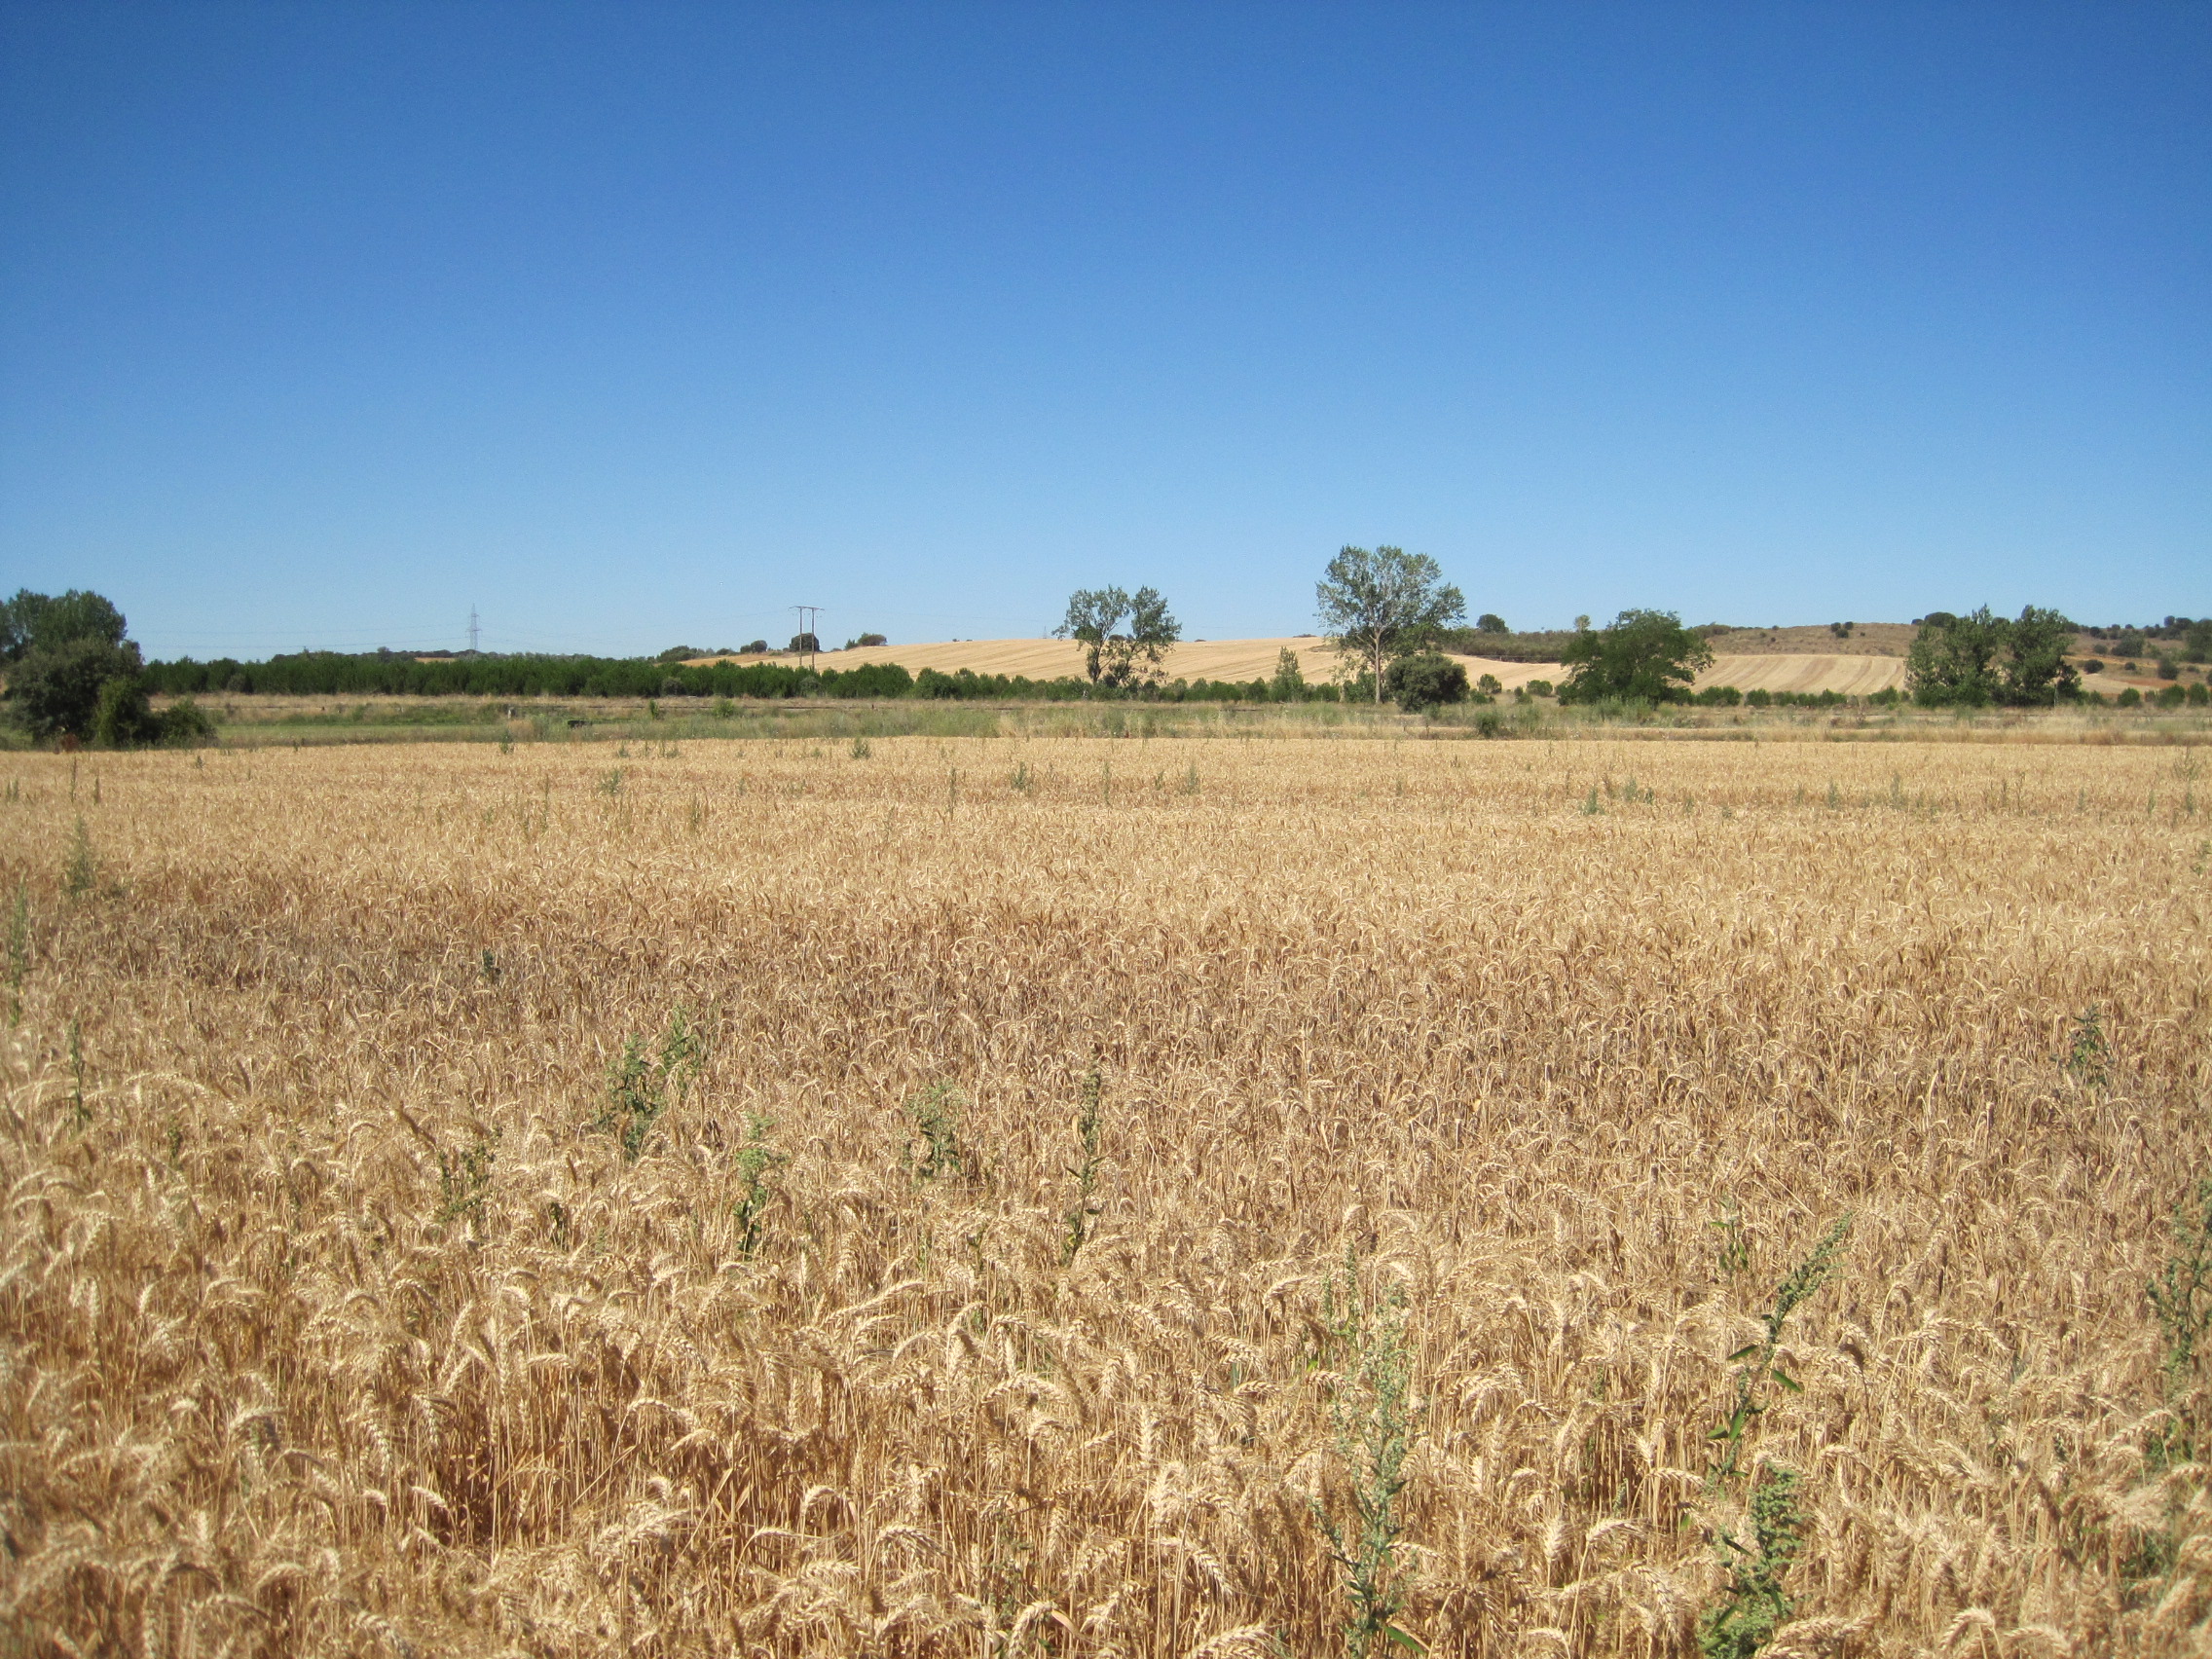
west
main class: Cropland
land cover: Common wheat
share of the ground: > 75 %
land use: Agriculture (excluding fallow land and kitchen gardens)
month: July
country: ES
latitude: 42.1711
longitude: -5.5992
